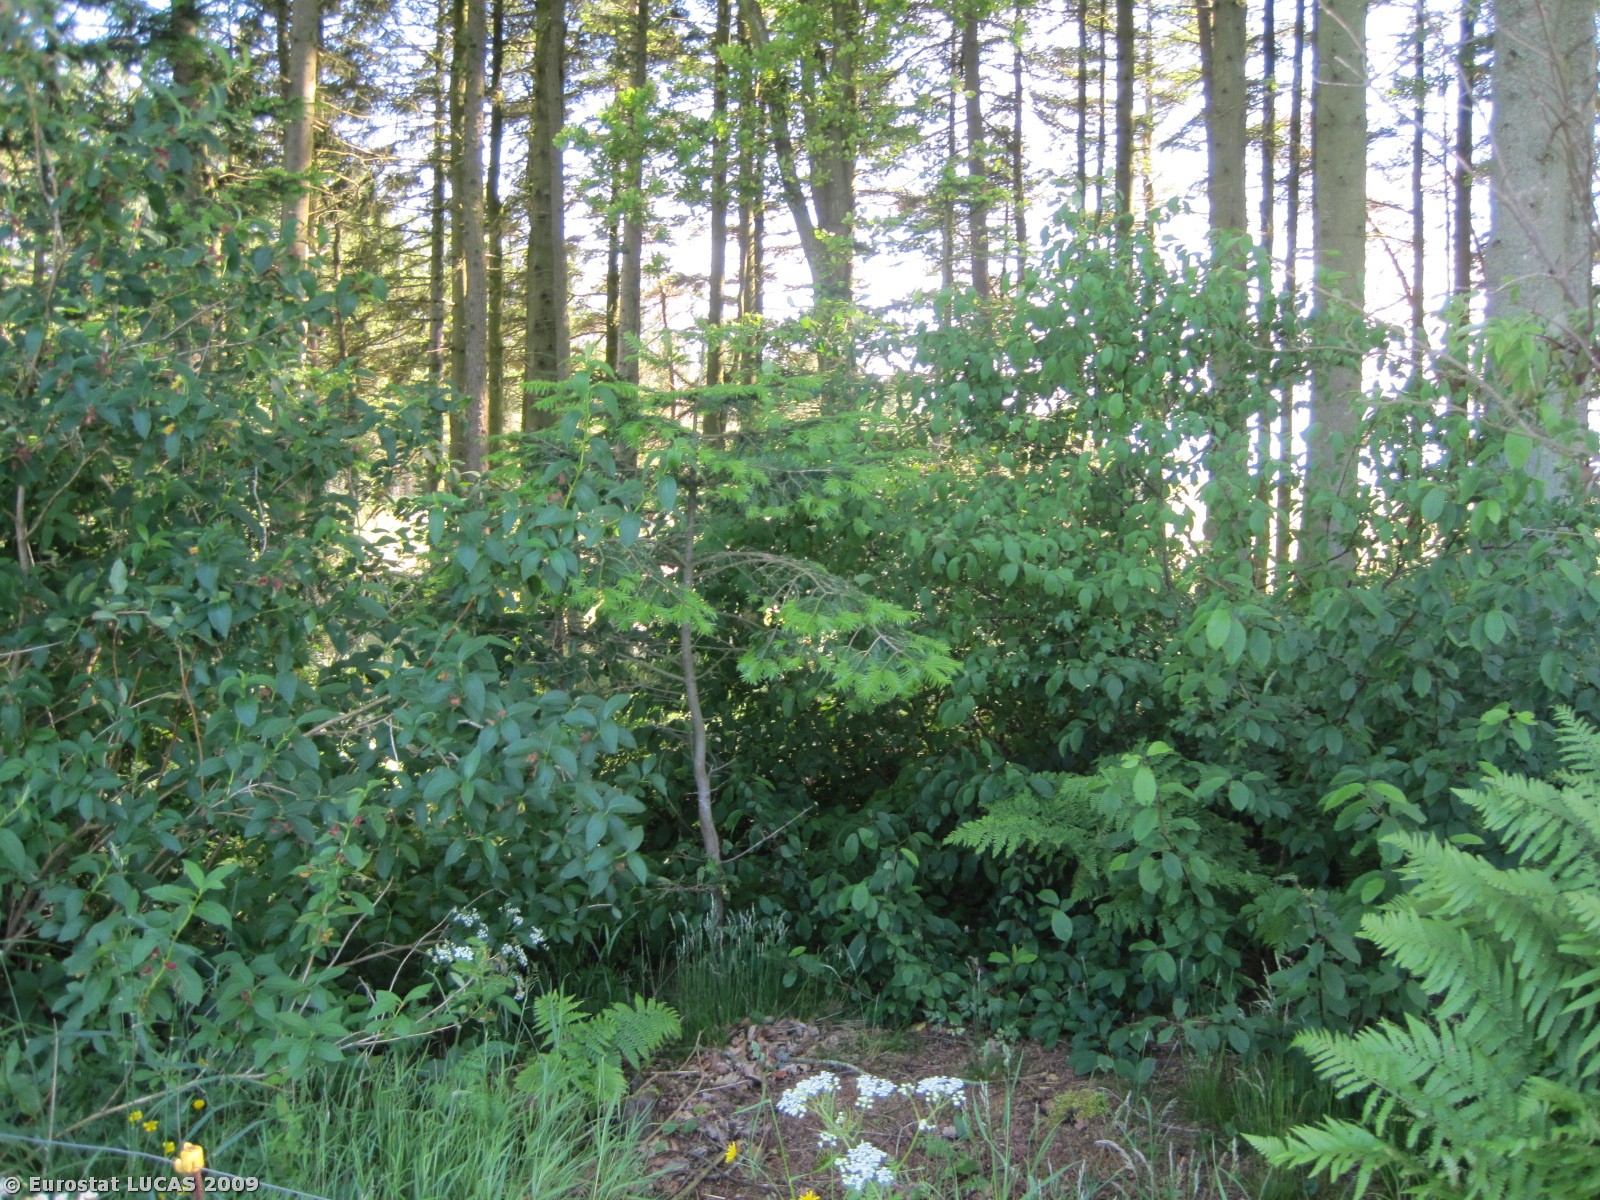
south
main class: Grassland
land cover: Grassland without tree/shrub cover
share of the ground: > 75 %
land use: Agriculture (excluding fallow land and kitchen gardens)
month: June
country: DK
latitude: 57.5181
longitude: 10.0833
